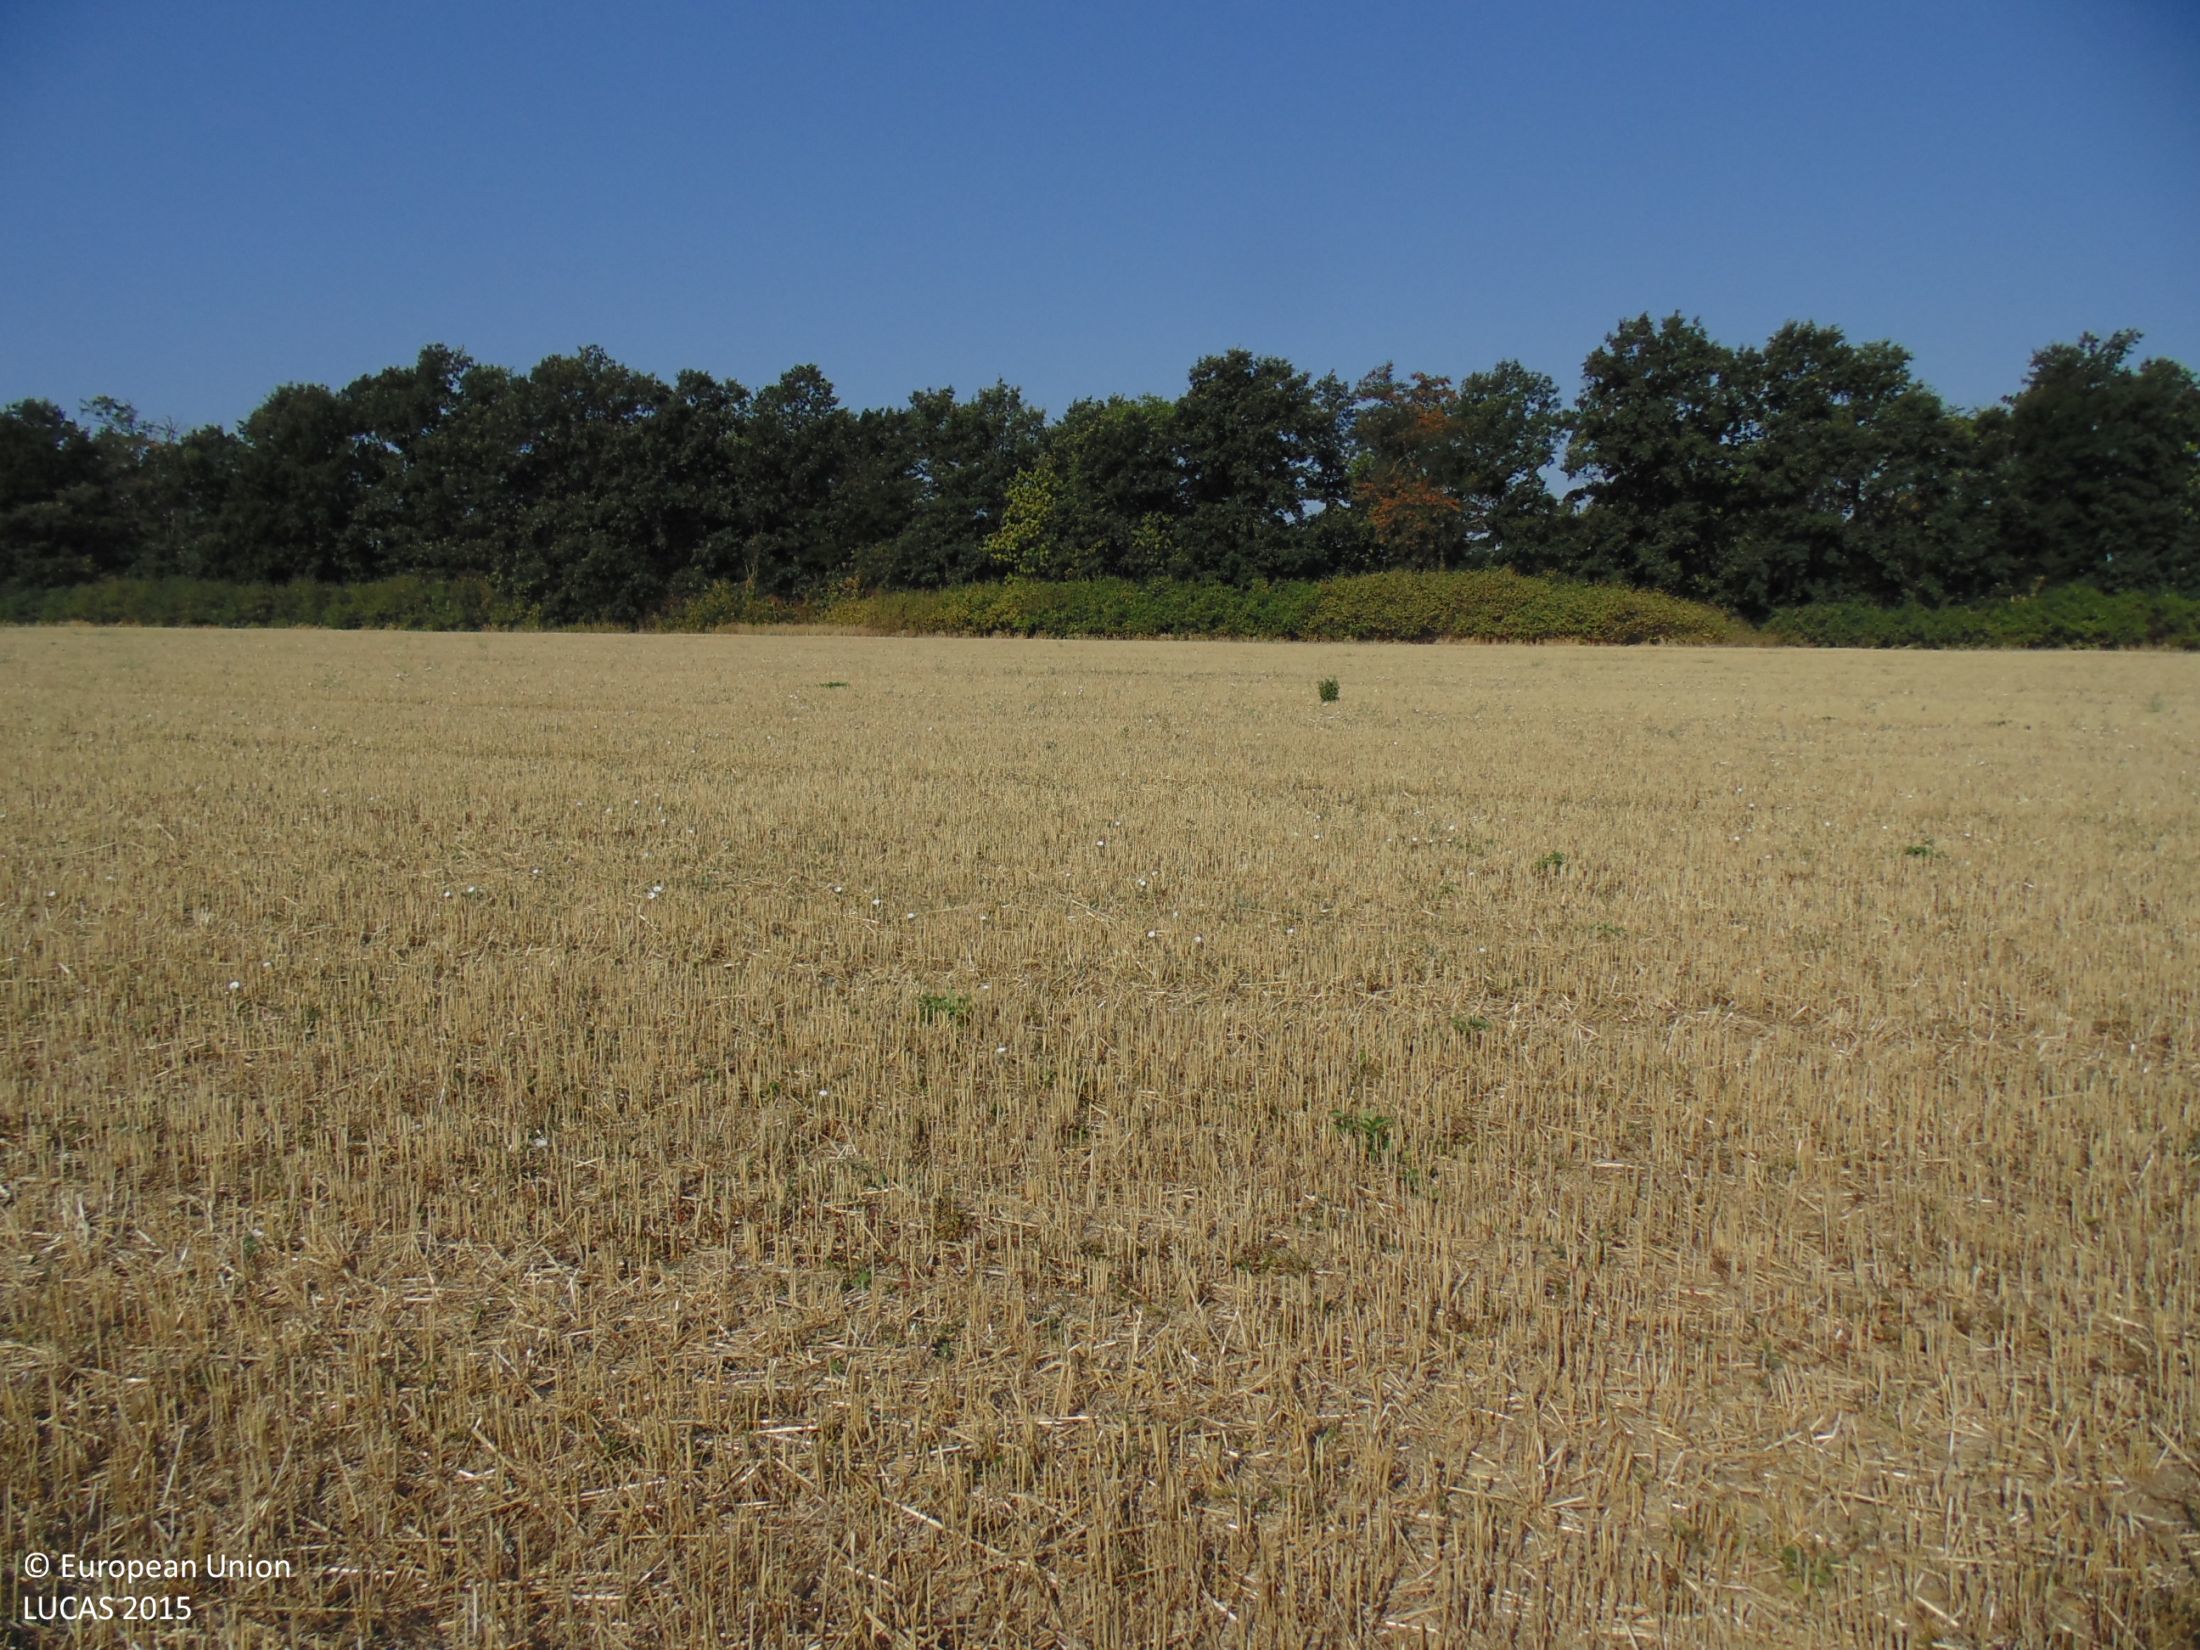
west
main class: Cropland
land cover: Common wheat
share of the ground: 50 - 75 %
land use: Agriculture (excluding fallow land and kitchen gardens)
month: August
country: BG
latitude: 44.0029
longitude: 27.4332
